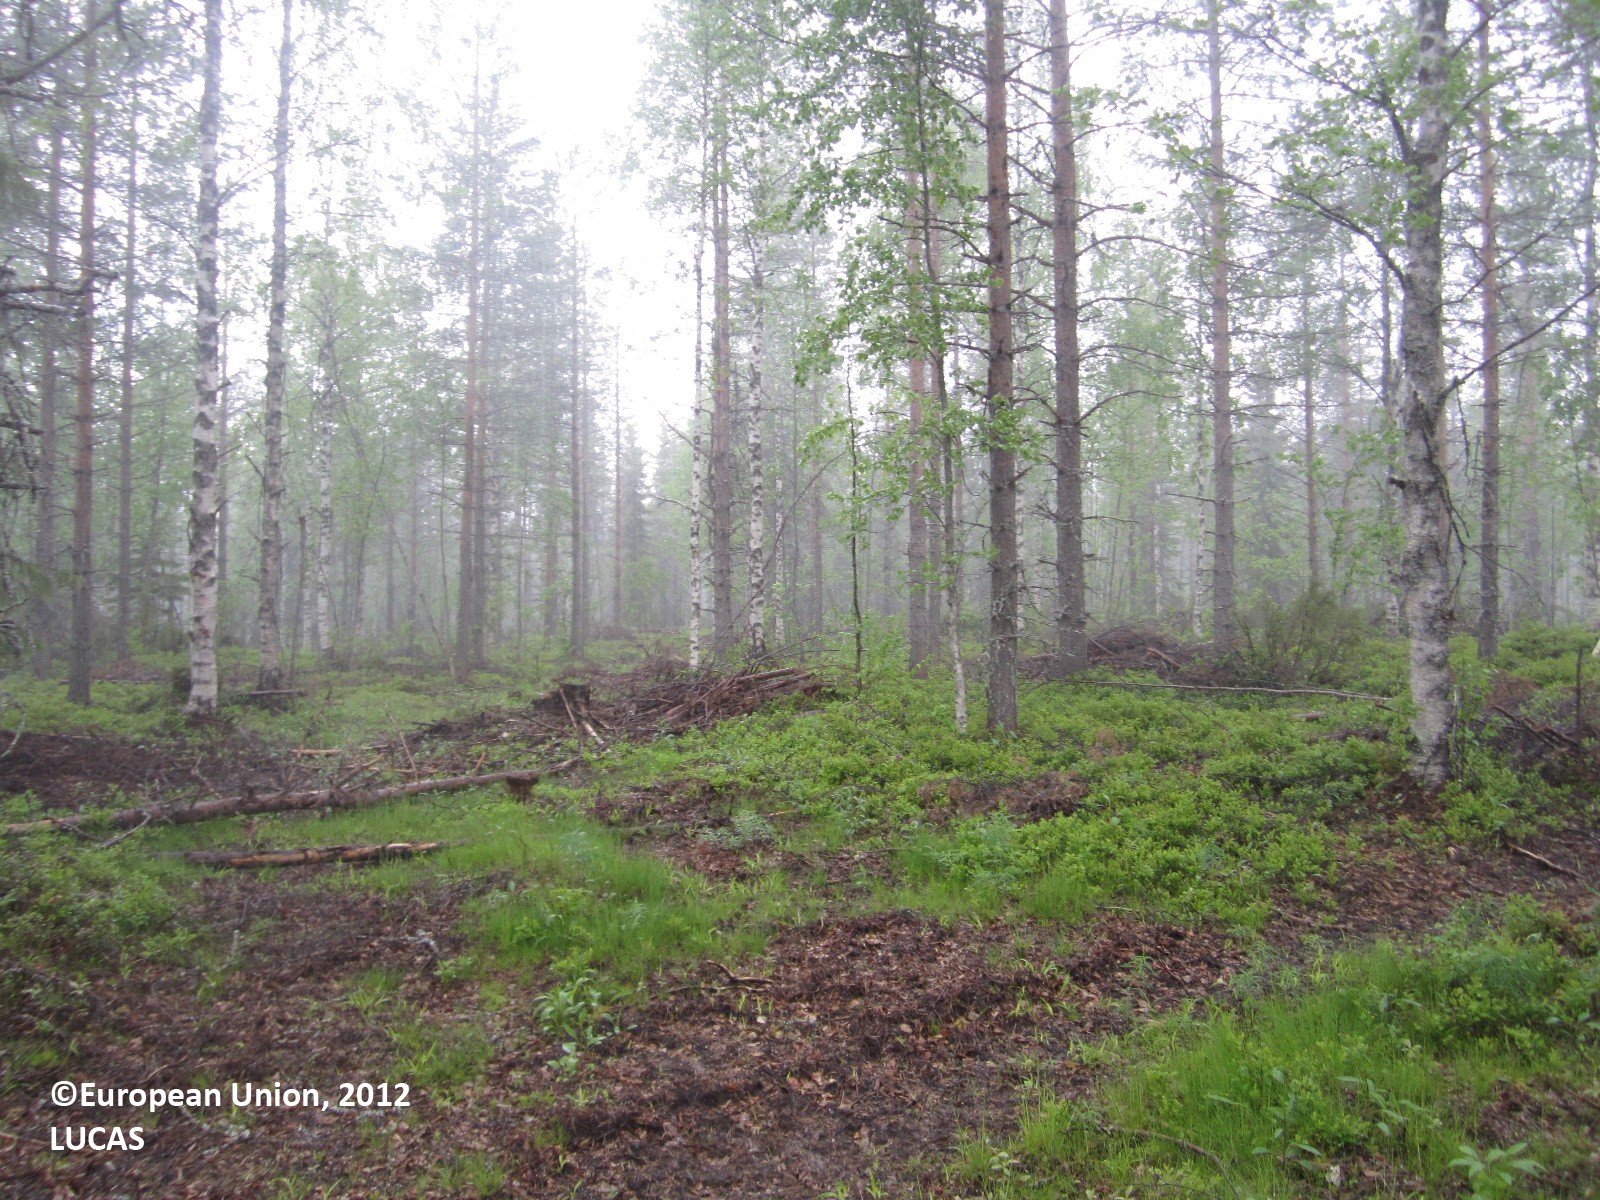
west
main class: Woodland
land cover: Pine dominated mixed woodland
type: boreal forest
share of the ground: > 75 %
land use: Forestry
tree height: > 5 m
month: June
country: FI
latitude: 64.8645
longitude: 29.4272
